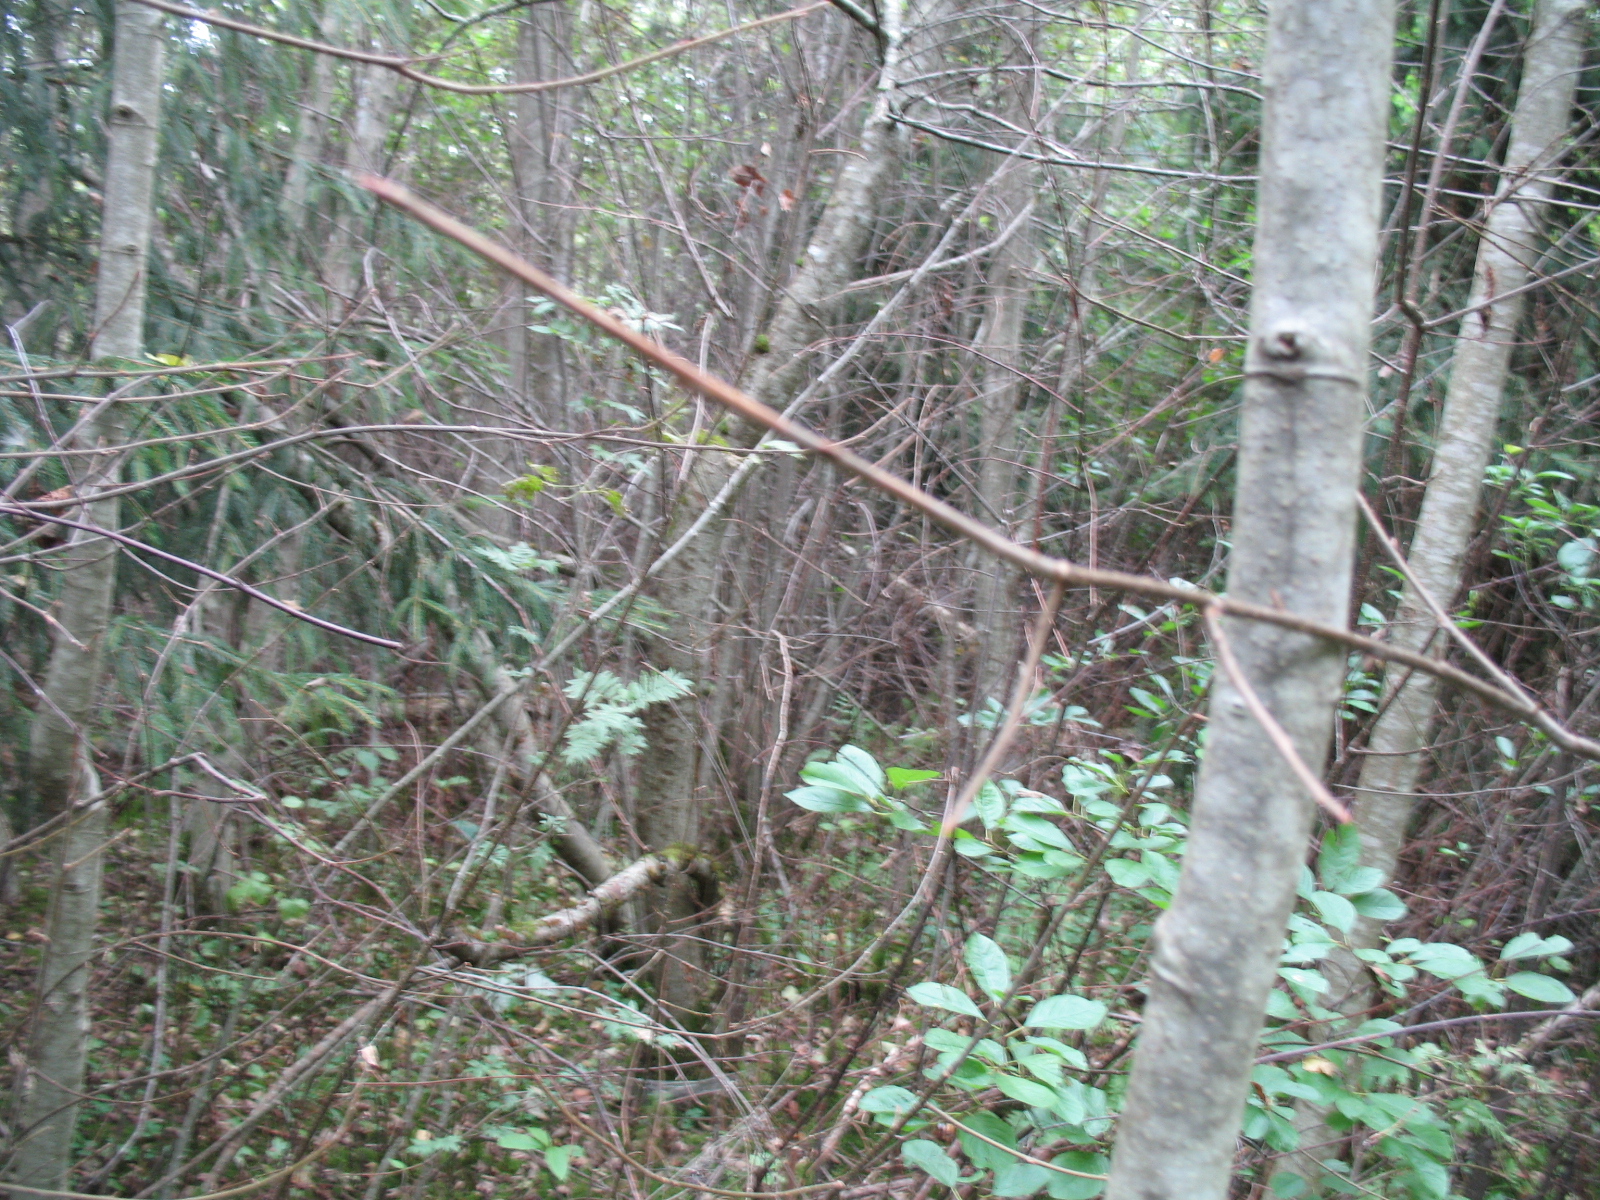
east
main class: Woodland
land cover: Broadleaved woodland
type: non-riverine alder, birch or aspen forest
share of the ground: > 75 %
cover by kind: broadleaved forest trees 80 %, coniferous forest trees 10 %, herbaceous plants 5 %, lichens and mosses 5 %
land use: Forestry
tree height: > 5 m
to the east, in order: Broadleaved woodland; Ditches and canals; Spruce dominated mixed woodland; Ditches and canals; Broadleaved woodland; Spruce dominated mixed woodland; Broadleaved woodland
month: August
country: LV
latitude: 56.2779
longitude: 25.5465
